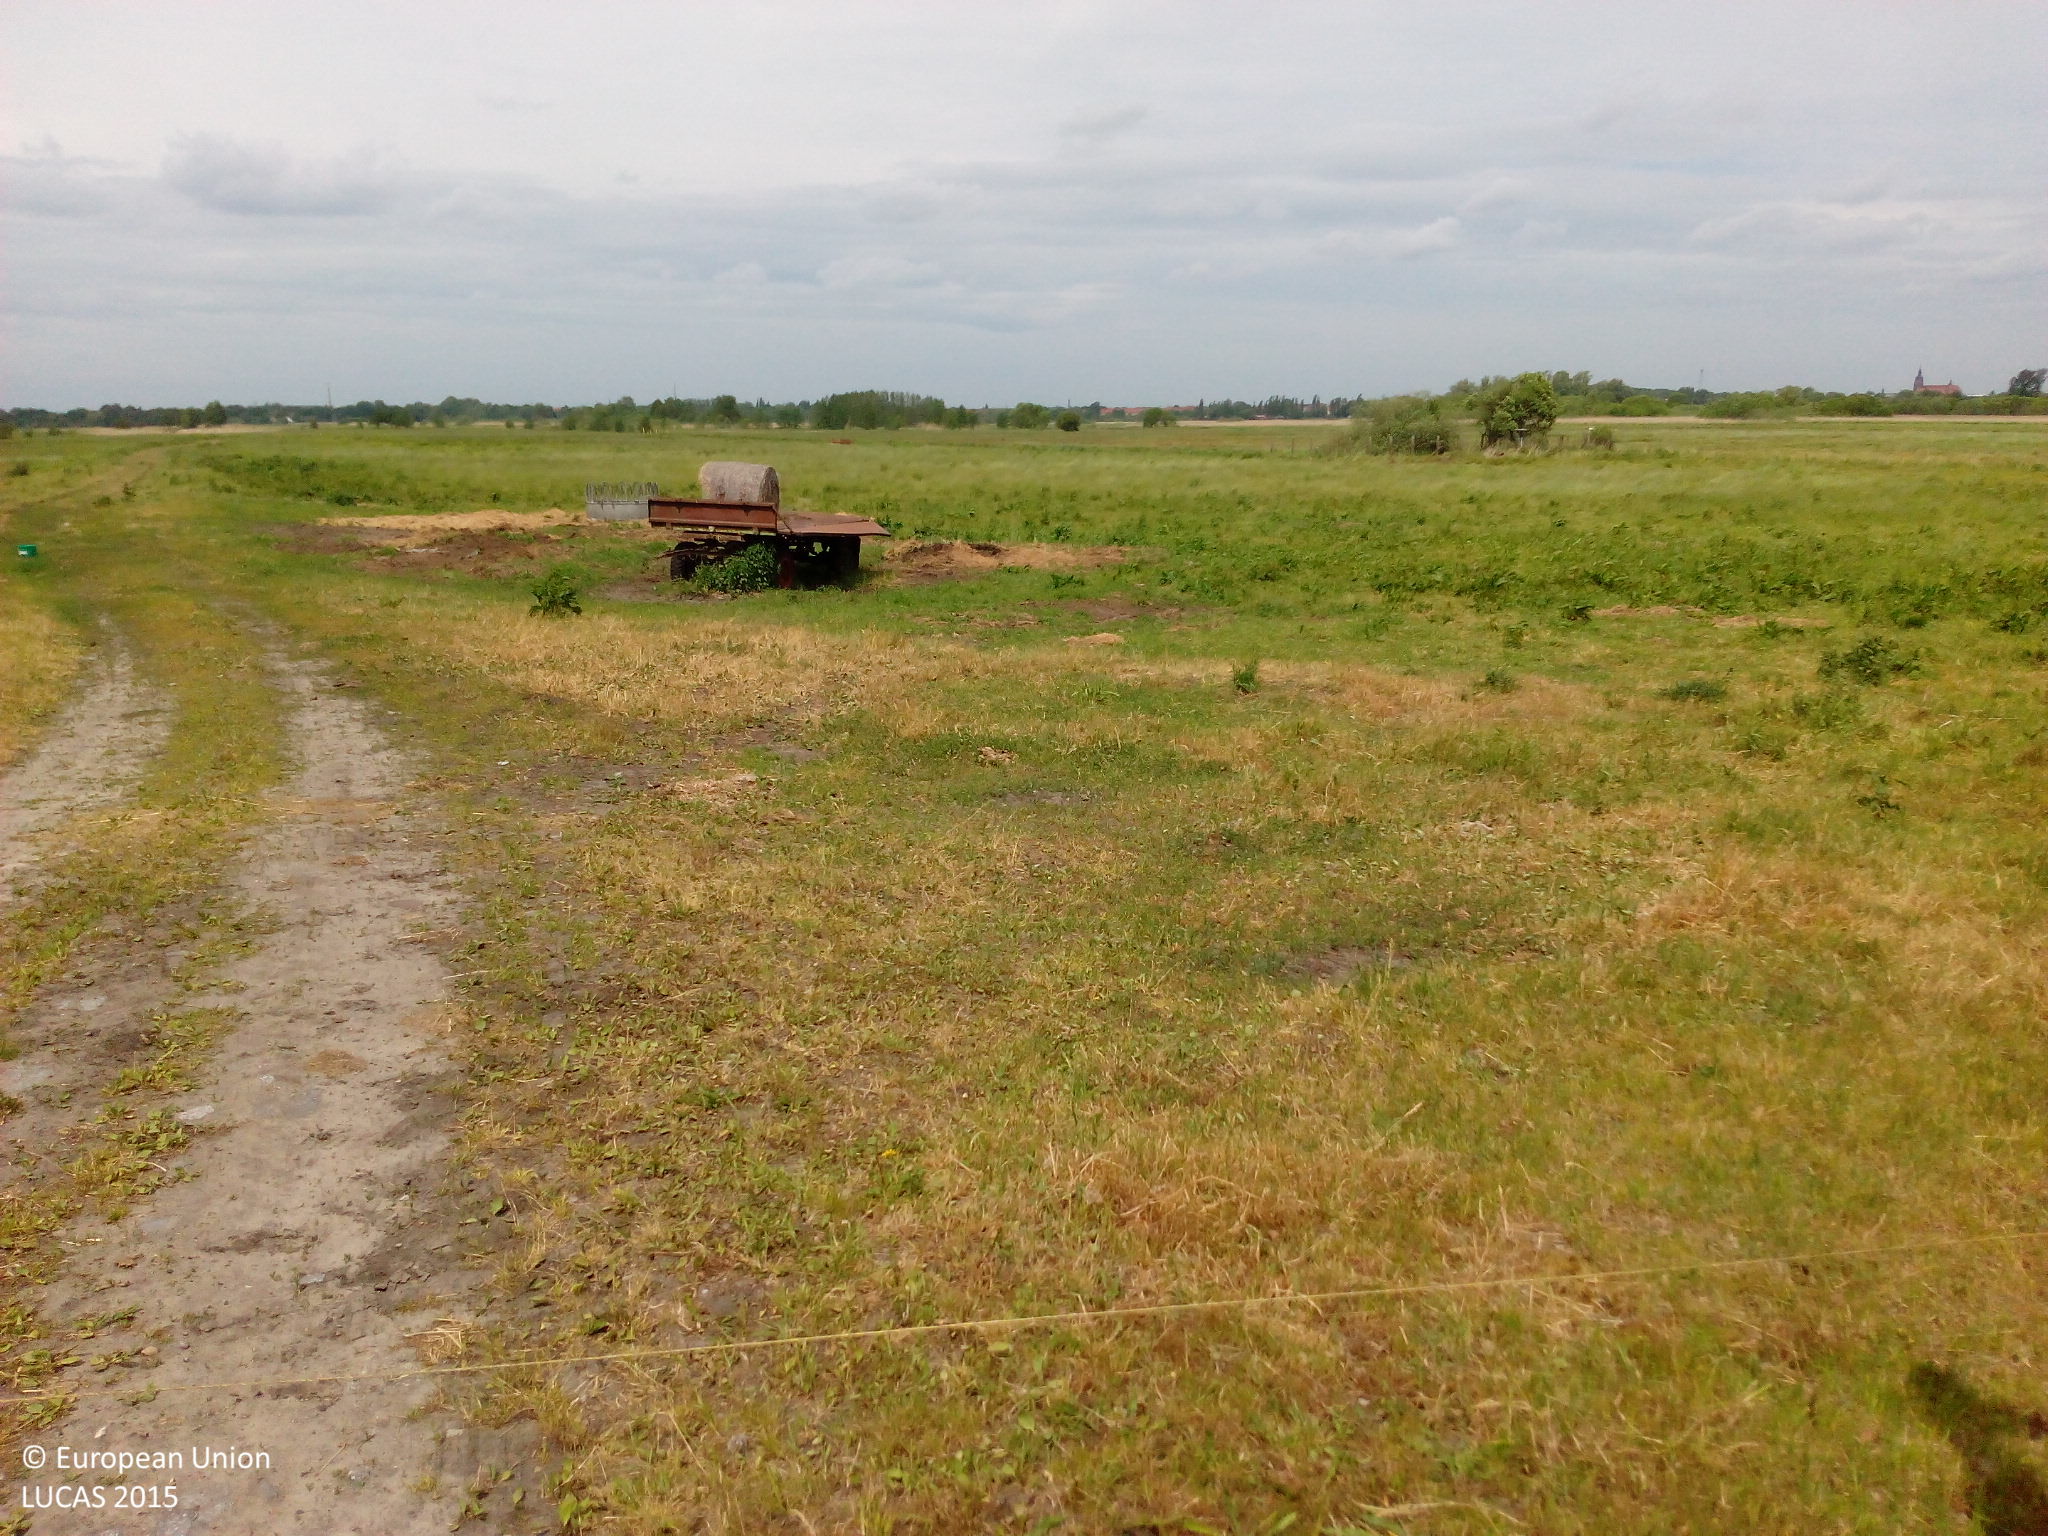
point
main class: Grassland
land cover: Grassland without tree/shrub cover
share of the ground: > 75 %
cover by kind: herbaceous plants 100 %
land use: Agriculture (excluding fallow land and kitchen gardens)
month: June
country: DE
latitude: 52.3856
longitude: 12.5709
